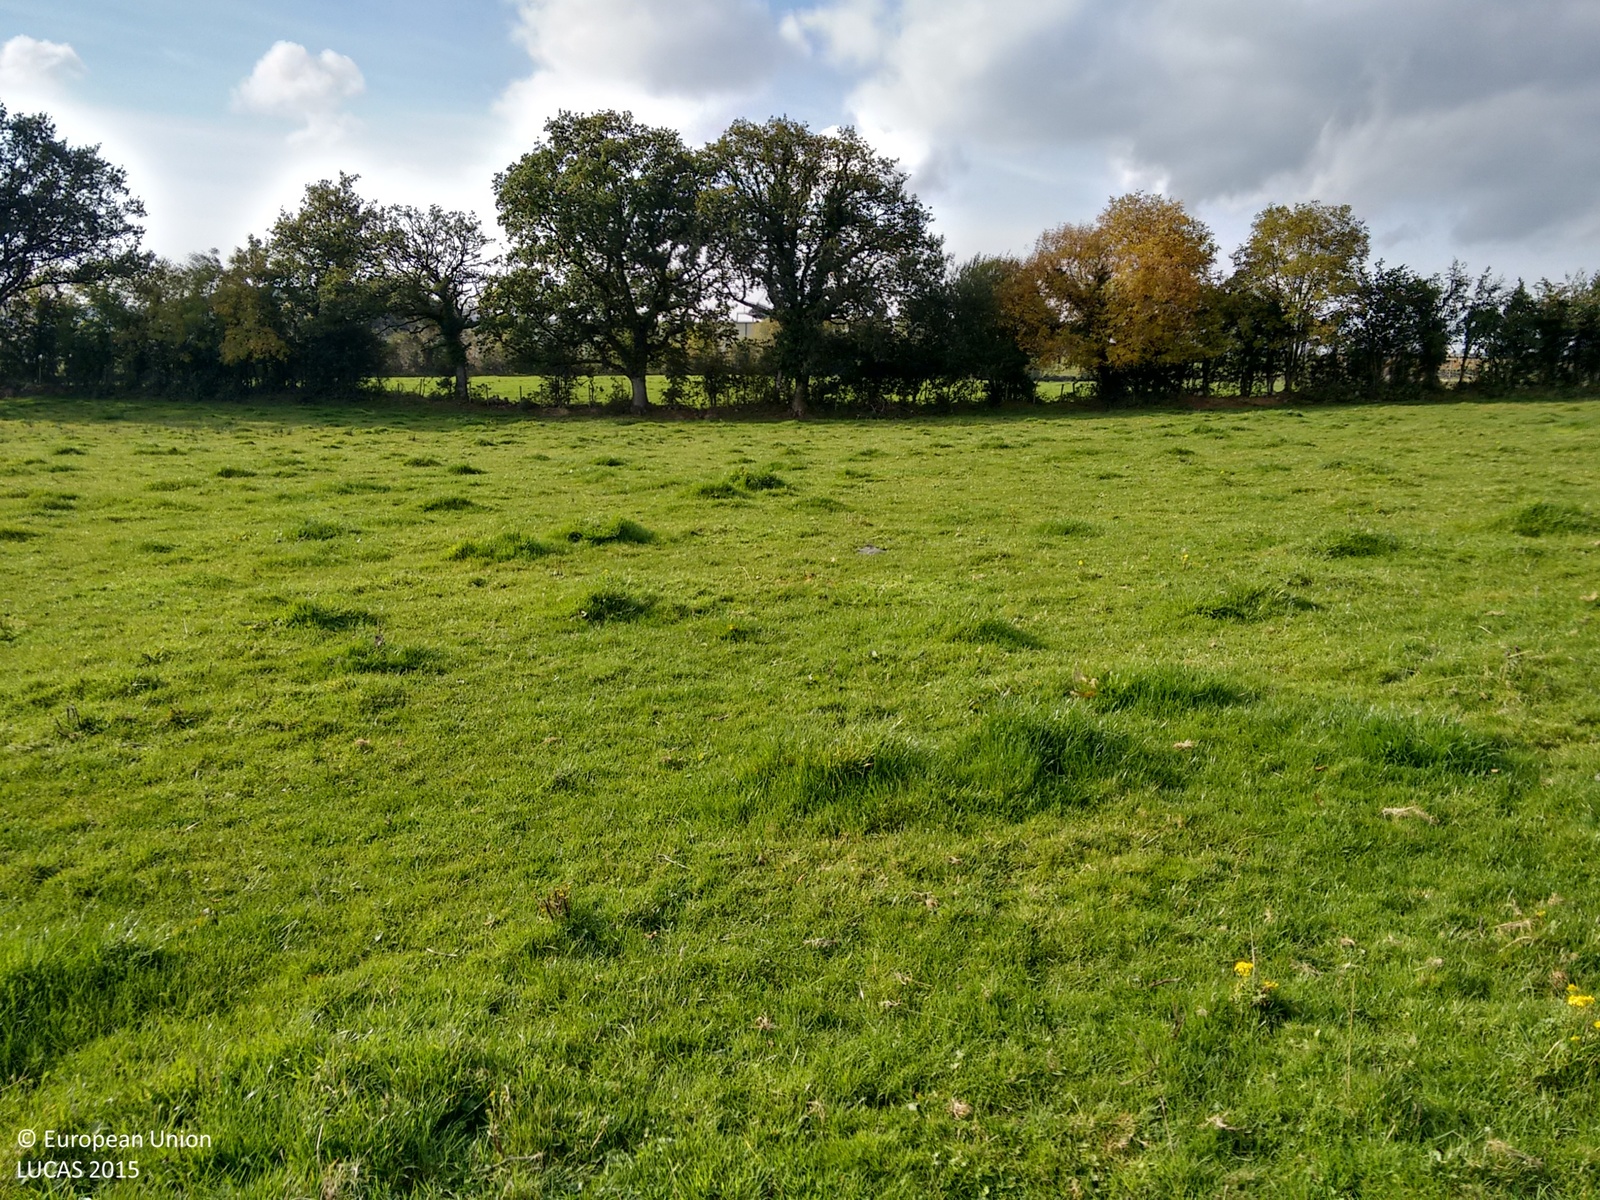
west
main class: Grassland
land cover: Grassland without tree/shrub cover
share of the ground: > 75 %
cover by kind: herbaceous plants 100 %
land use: Agriculture (excluding fallow land and kitchen gardens)
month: October
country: GB
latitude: 54.1837
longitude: -7.5819
